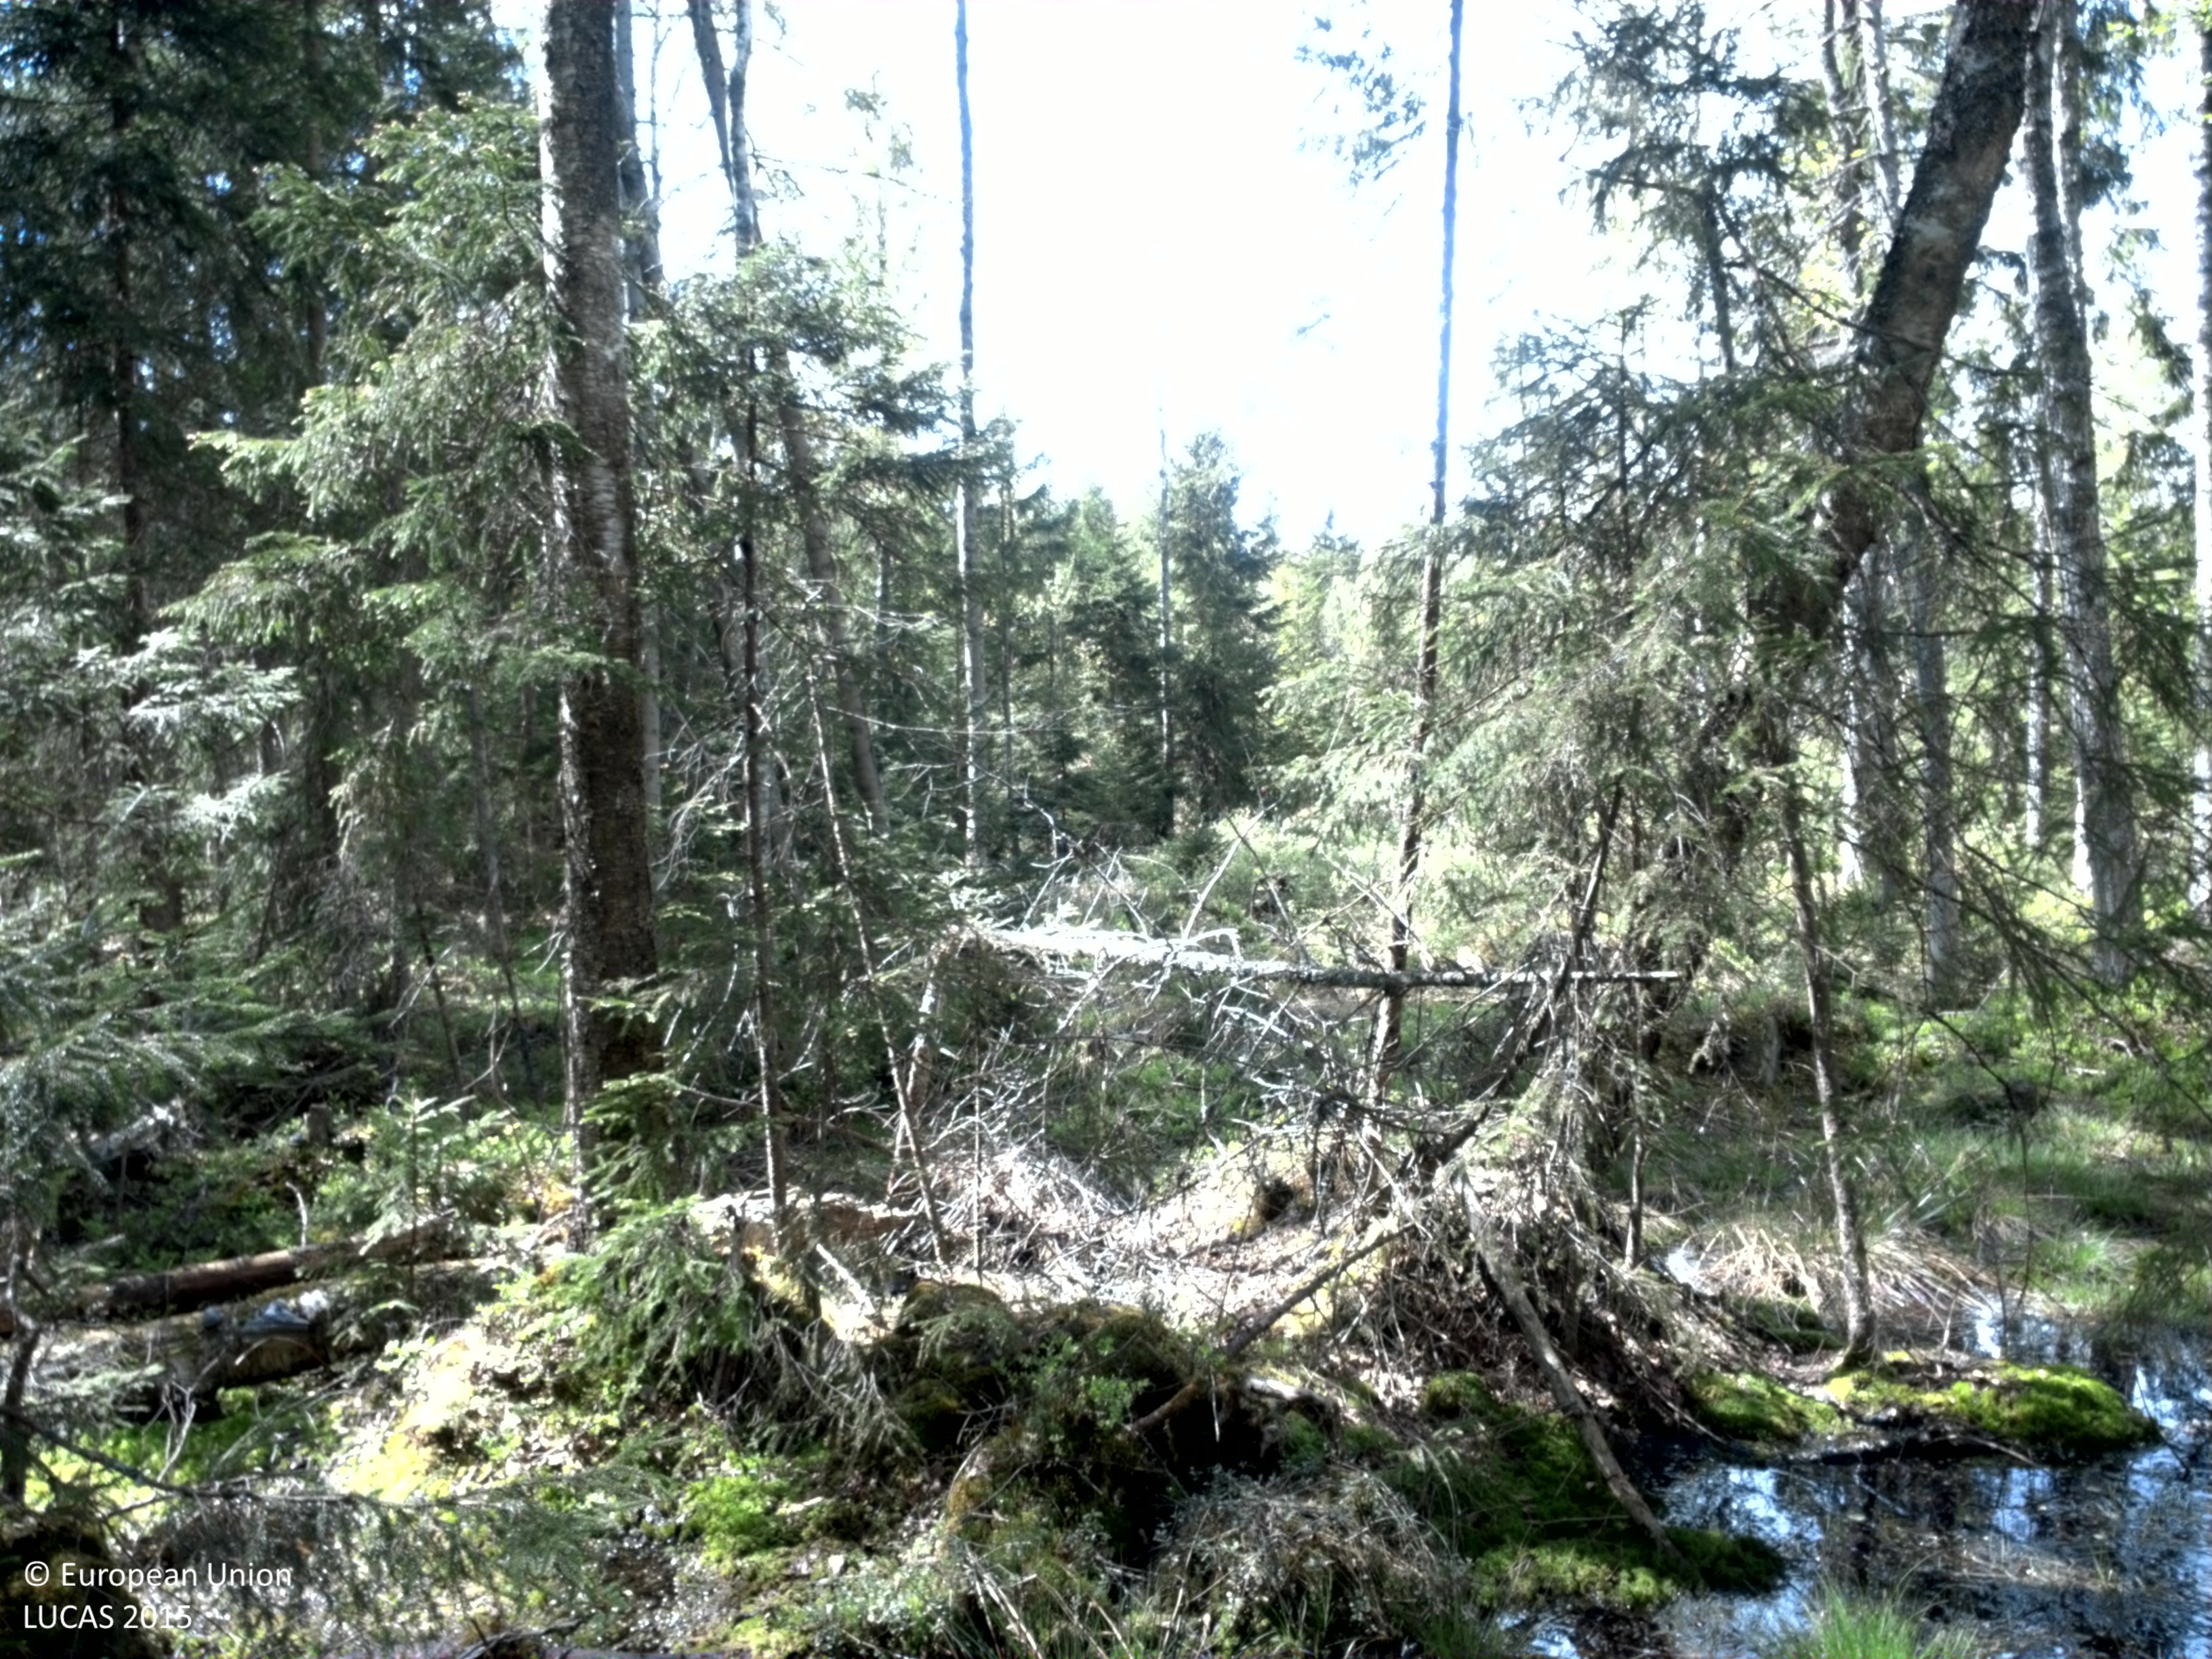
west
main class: Woodland
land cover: Spruce dominated mixed woodland
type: boreal forest
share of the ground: > 75 %
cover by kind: broadleaved forest trees 50 %, coniferous forest trees 40 %, lichens and mosses 10 %
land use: Forestry
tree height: > 5 m
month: May
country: SE
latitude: 56.7319
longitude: 15.1794
